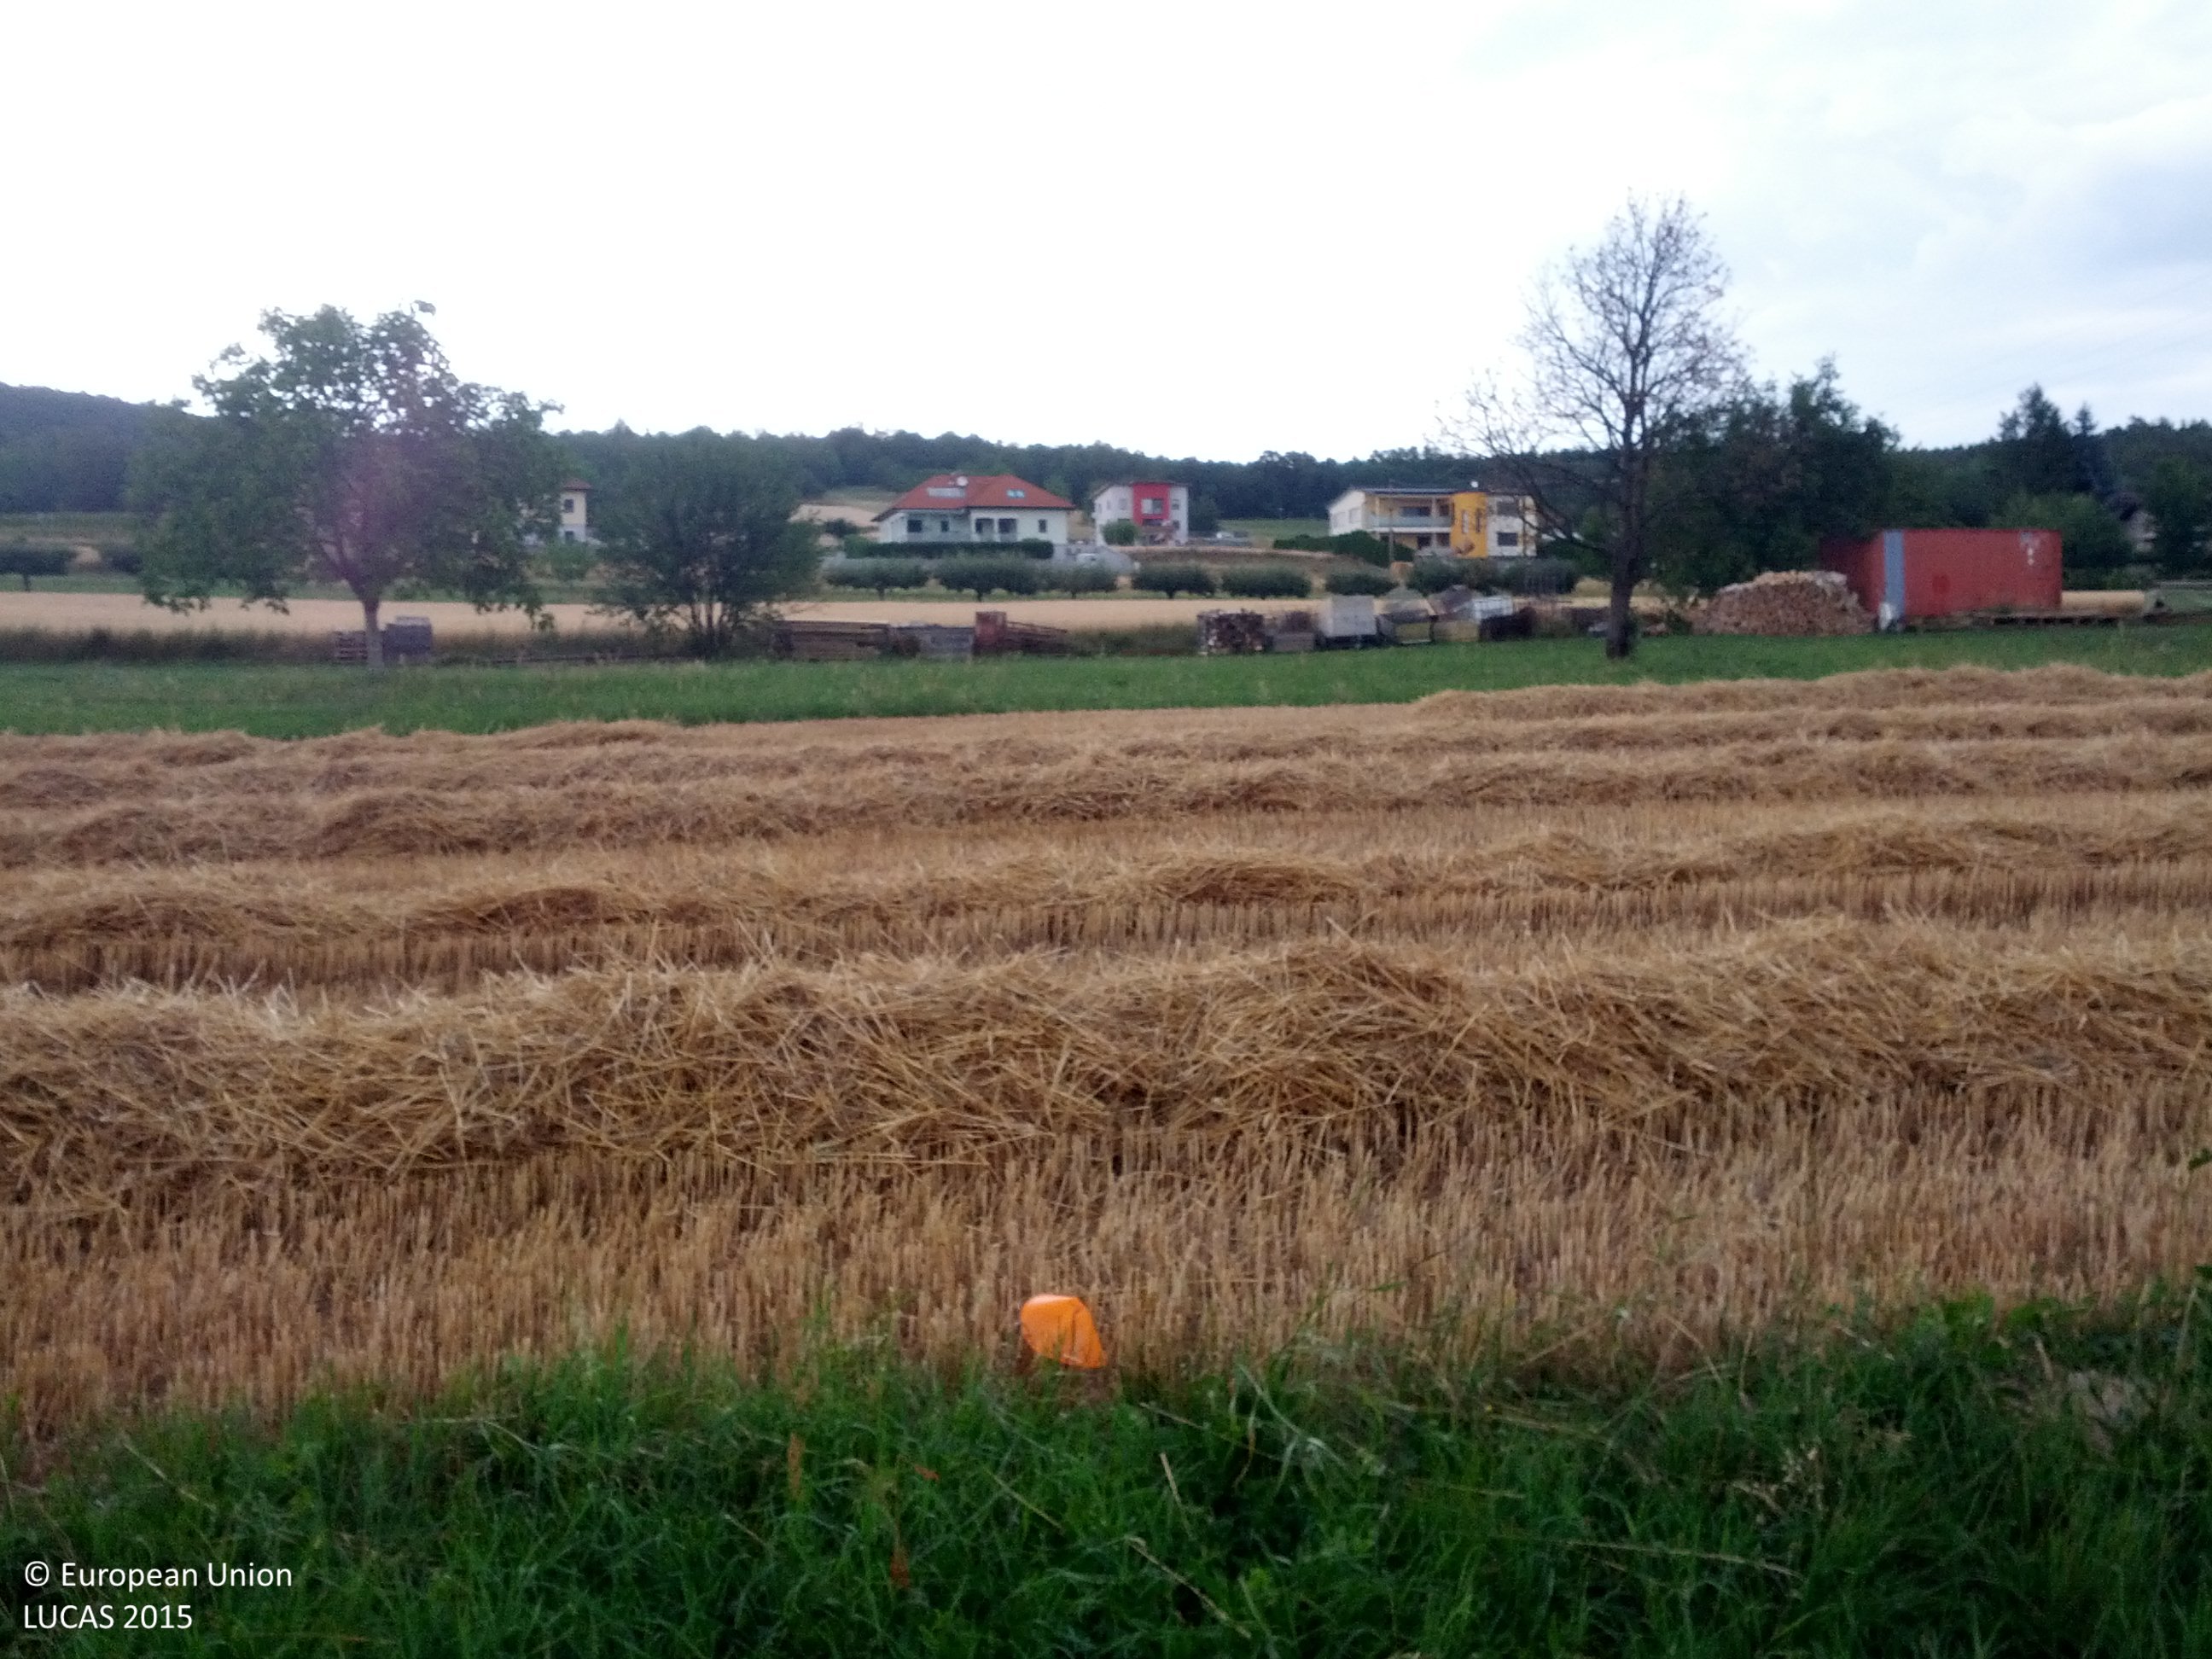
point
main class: Cropland
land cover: Common wheat
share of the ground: 10 - 25 %
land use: Agriculture (excluding fallow land and kitchen gardens)
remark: Harvested field
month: July
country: AT
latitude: 47.2979
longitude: 16.3904
